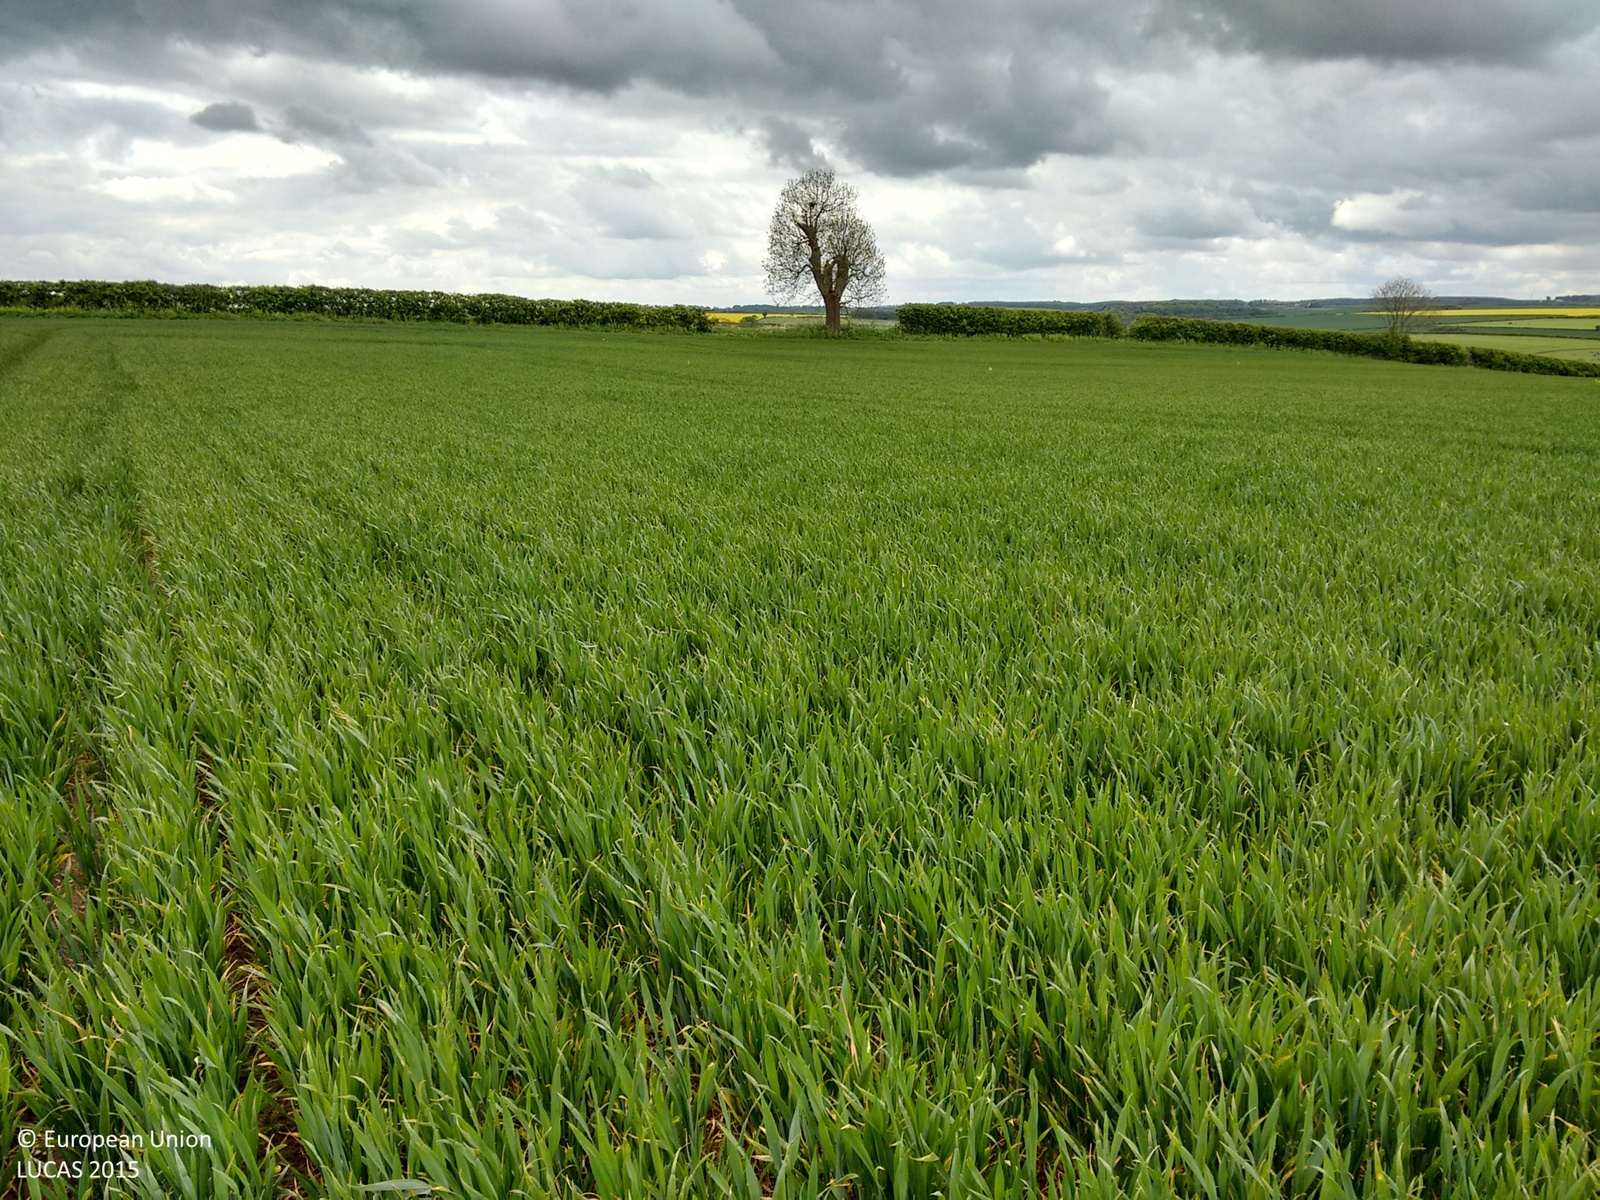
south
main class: Cropland
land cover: Common wheat
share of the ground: > 75 %
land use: Agriculture (excluding fallow land and kitchen gardens)
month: May
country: GB
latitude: 53.5128
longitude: -0.2130
